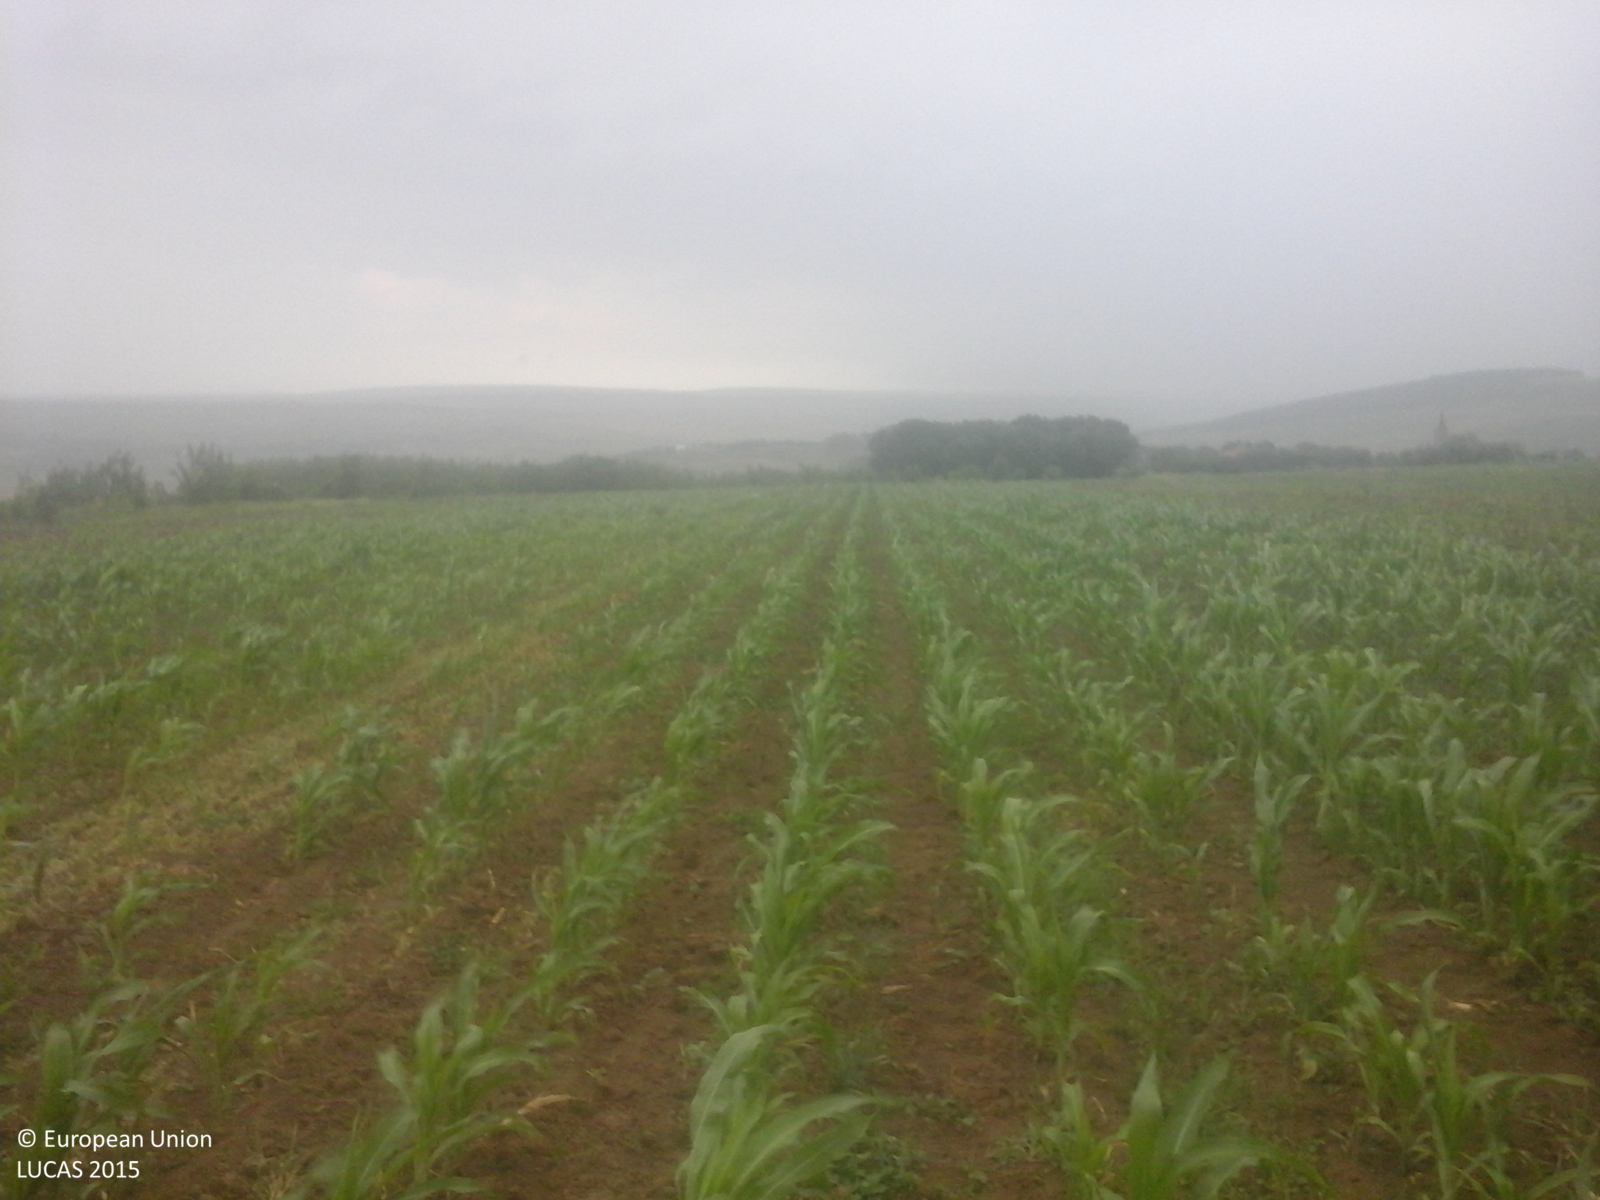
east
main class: Cropland
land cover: Maize
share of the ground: 50 - 75 %
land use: Agriculture (excluding fallow land and kitchen gardens)
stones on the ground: < 10 %
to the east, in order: Maize; Grassland without tree/shrub cover; Maize; Grass margins; Maize; Grassland with sparse tree/shrub cover
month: June
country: RO
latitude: 47.6772
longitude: 26.7881
